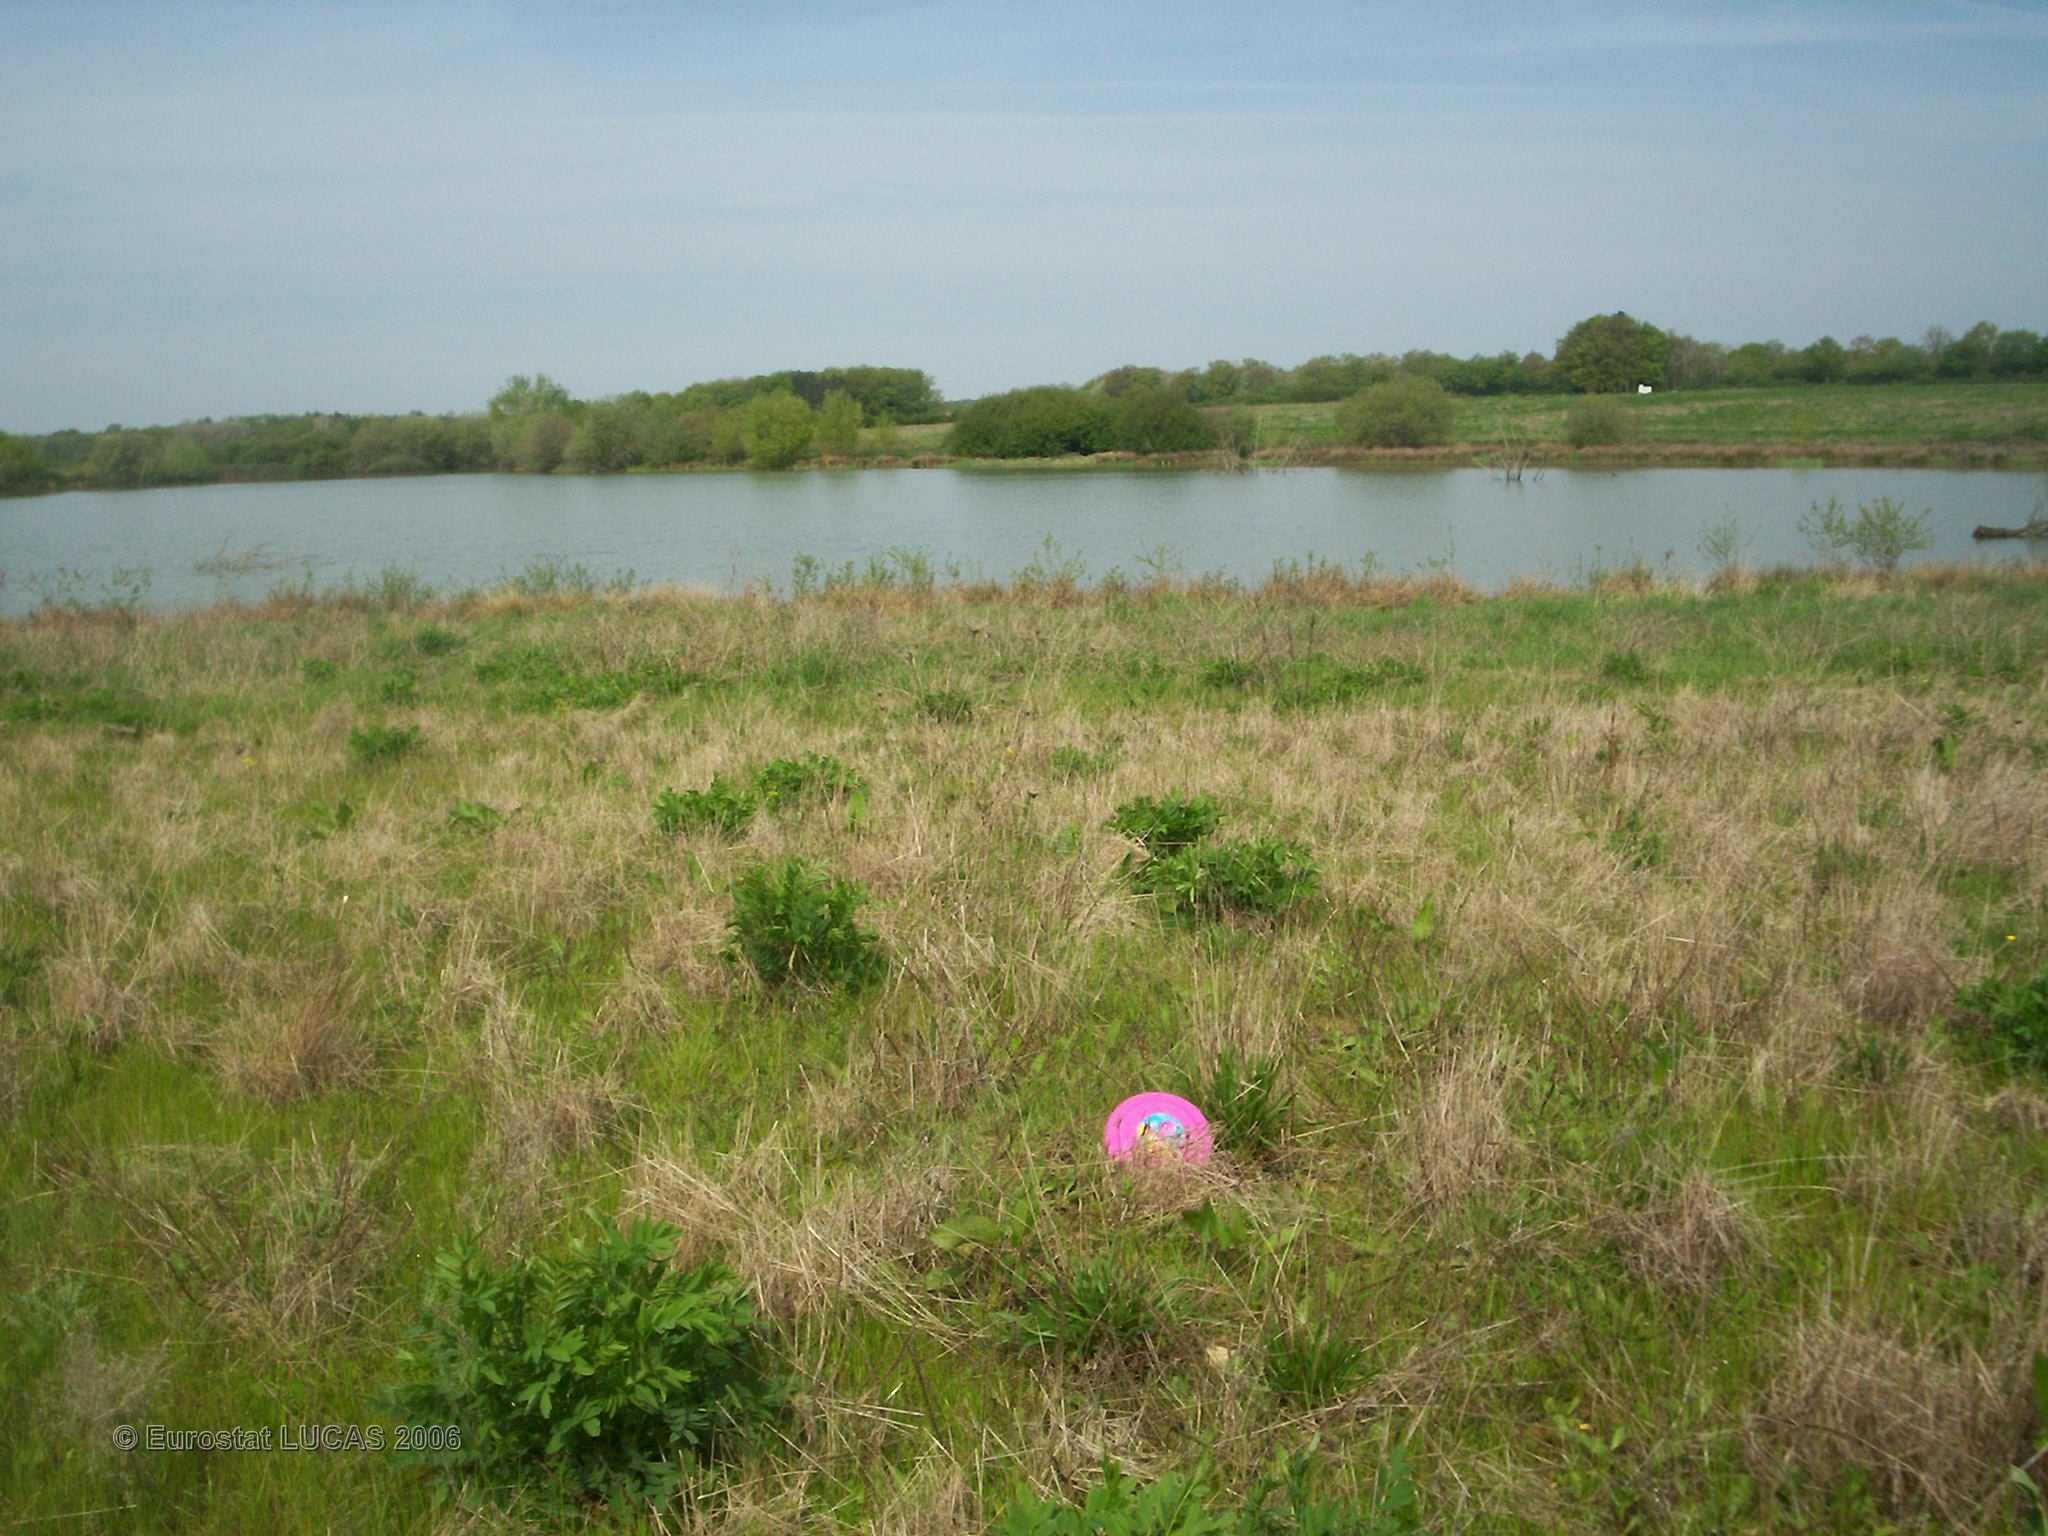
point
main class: Grassland
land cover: Grassland without tree/shrub cover
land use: Fallow land
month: May
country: FR
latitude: 47.6025
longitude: 2.9843
